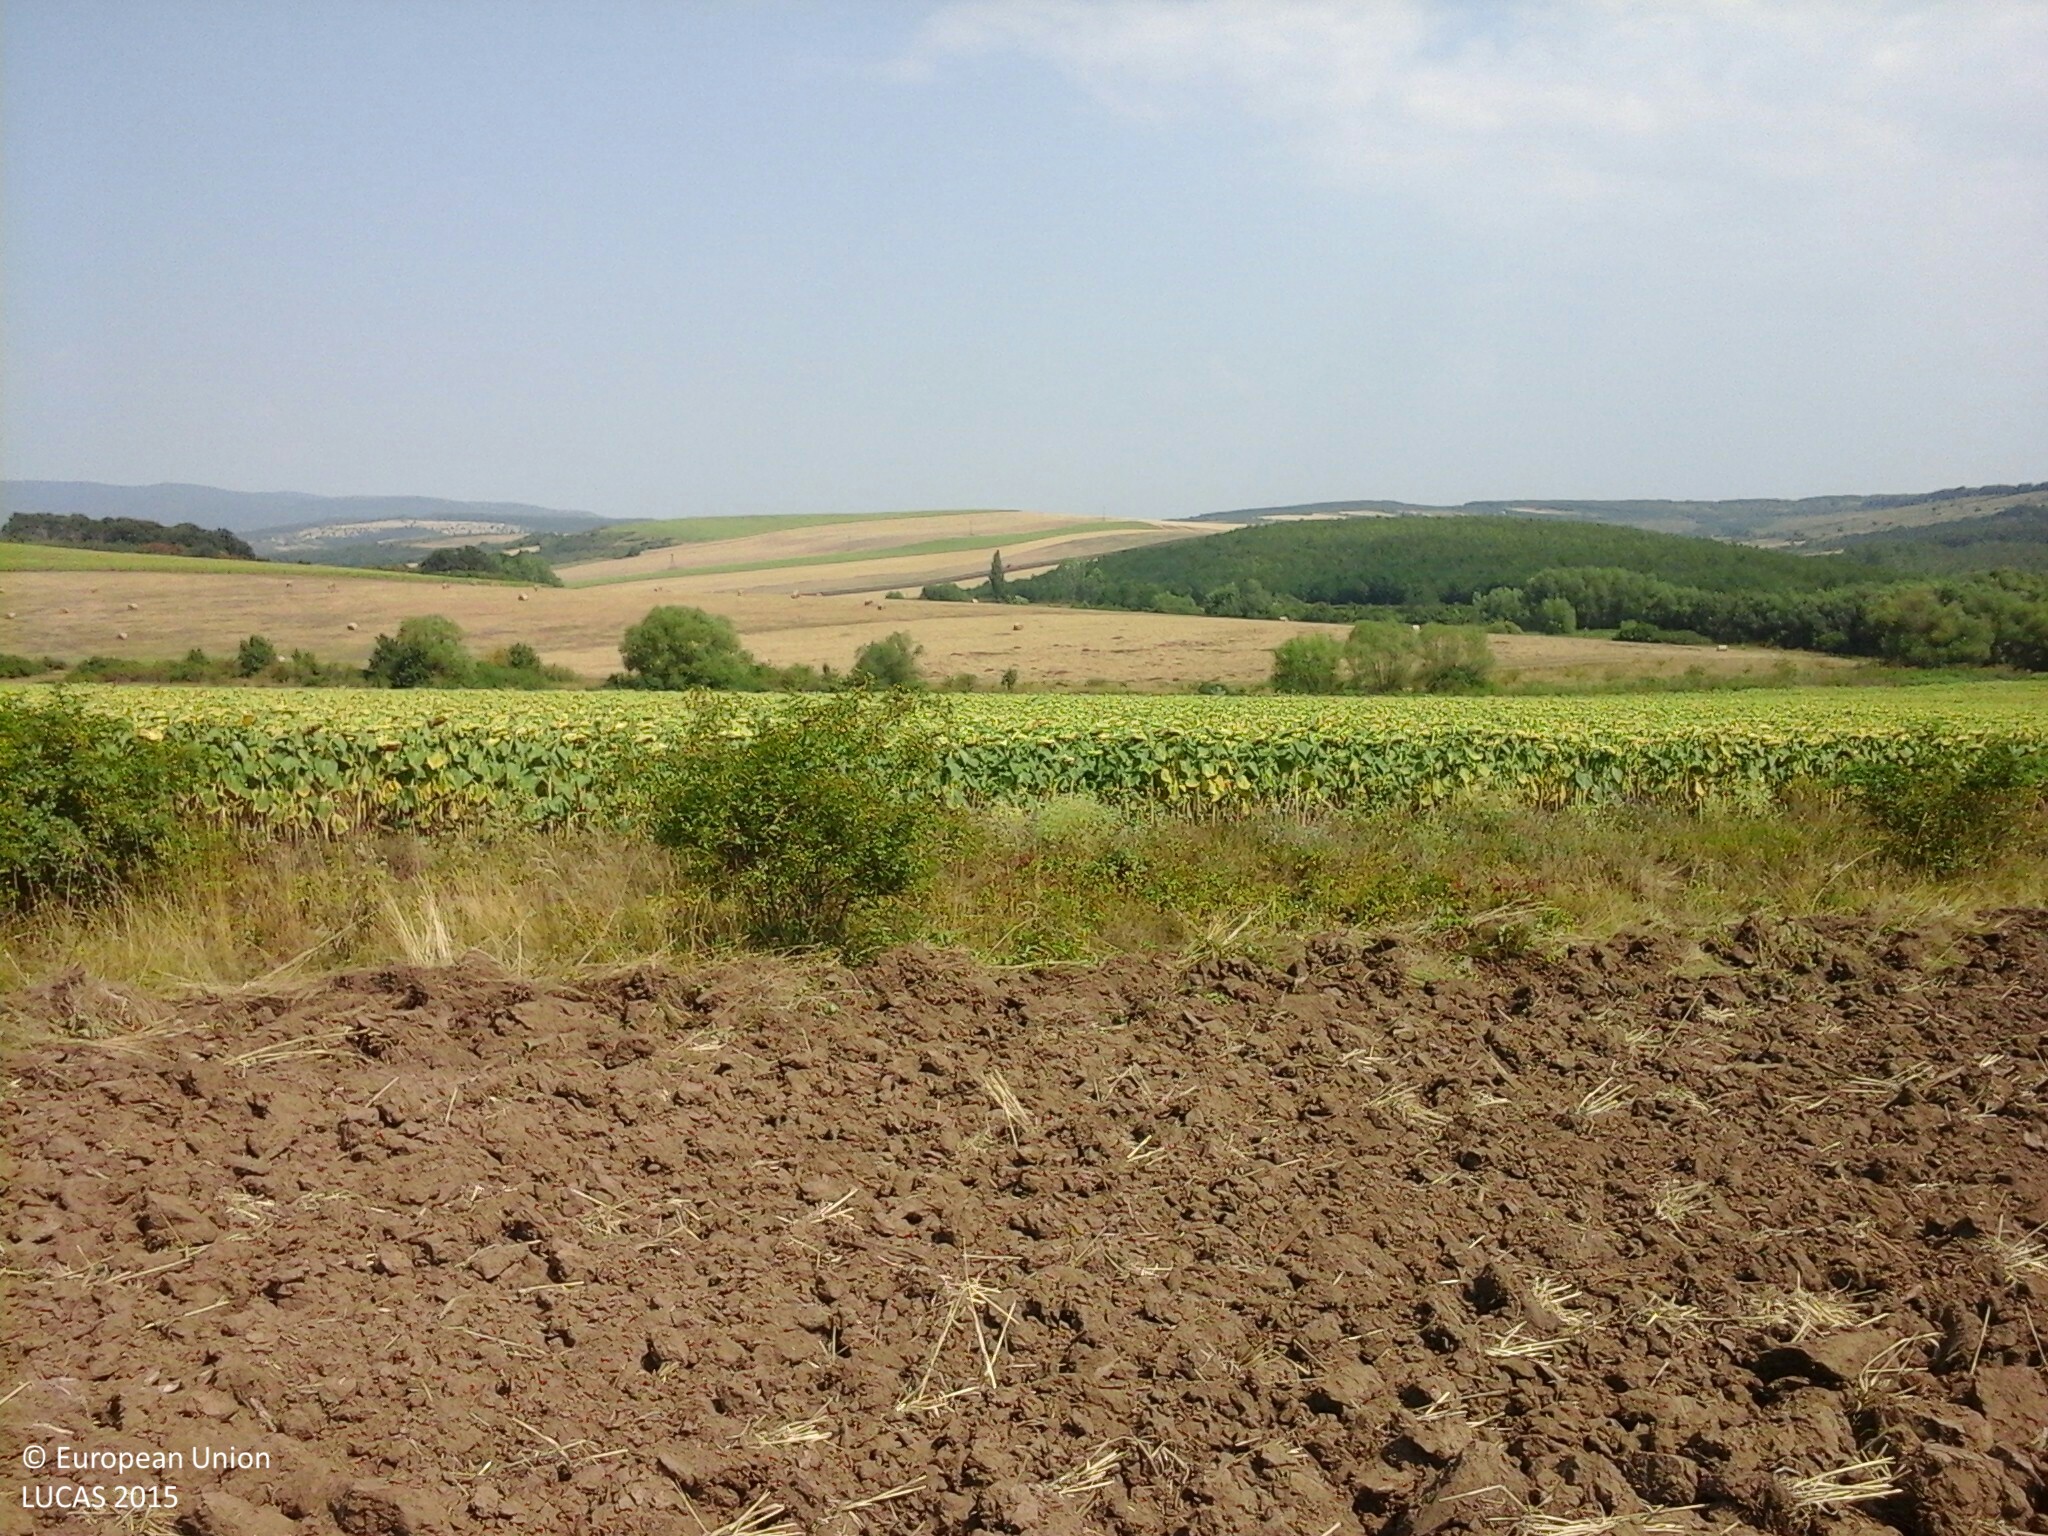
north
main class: Cropland
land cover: Common wheat
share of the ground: < 10 %
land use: Agriculture (excluding fallow land and kitchen gardens)
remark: Harvested field
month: August
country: HU
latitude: 47.9368
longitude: 20.7040
